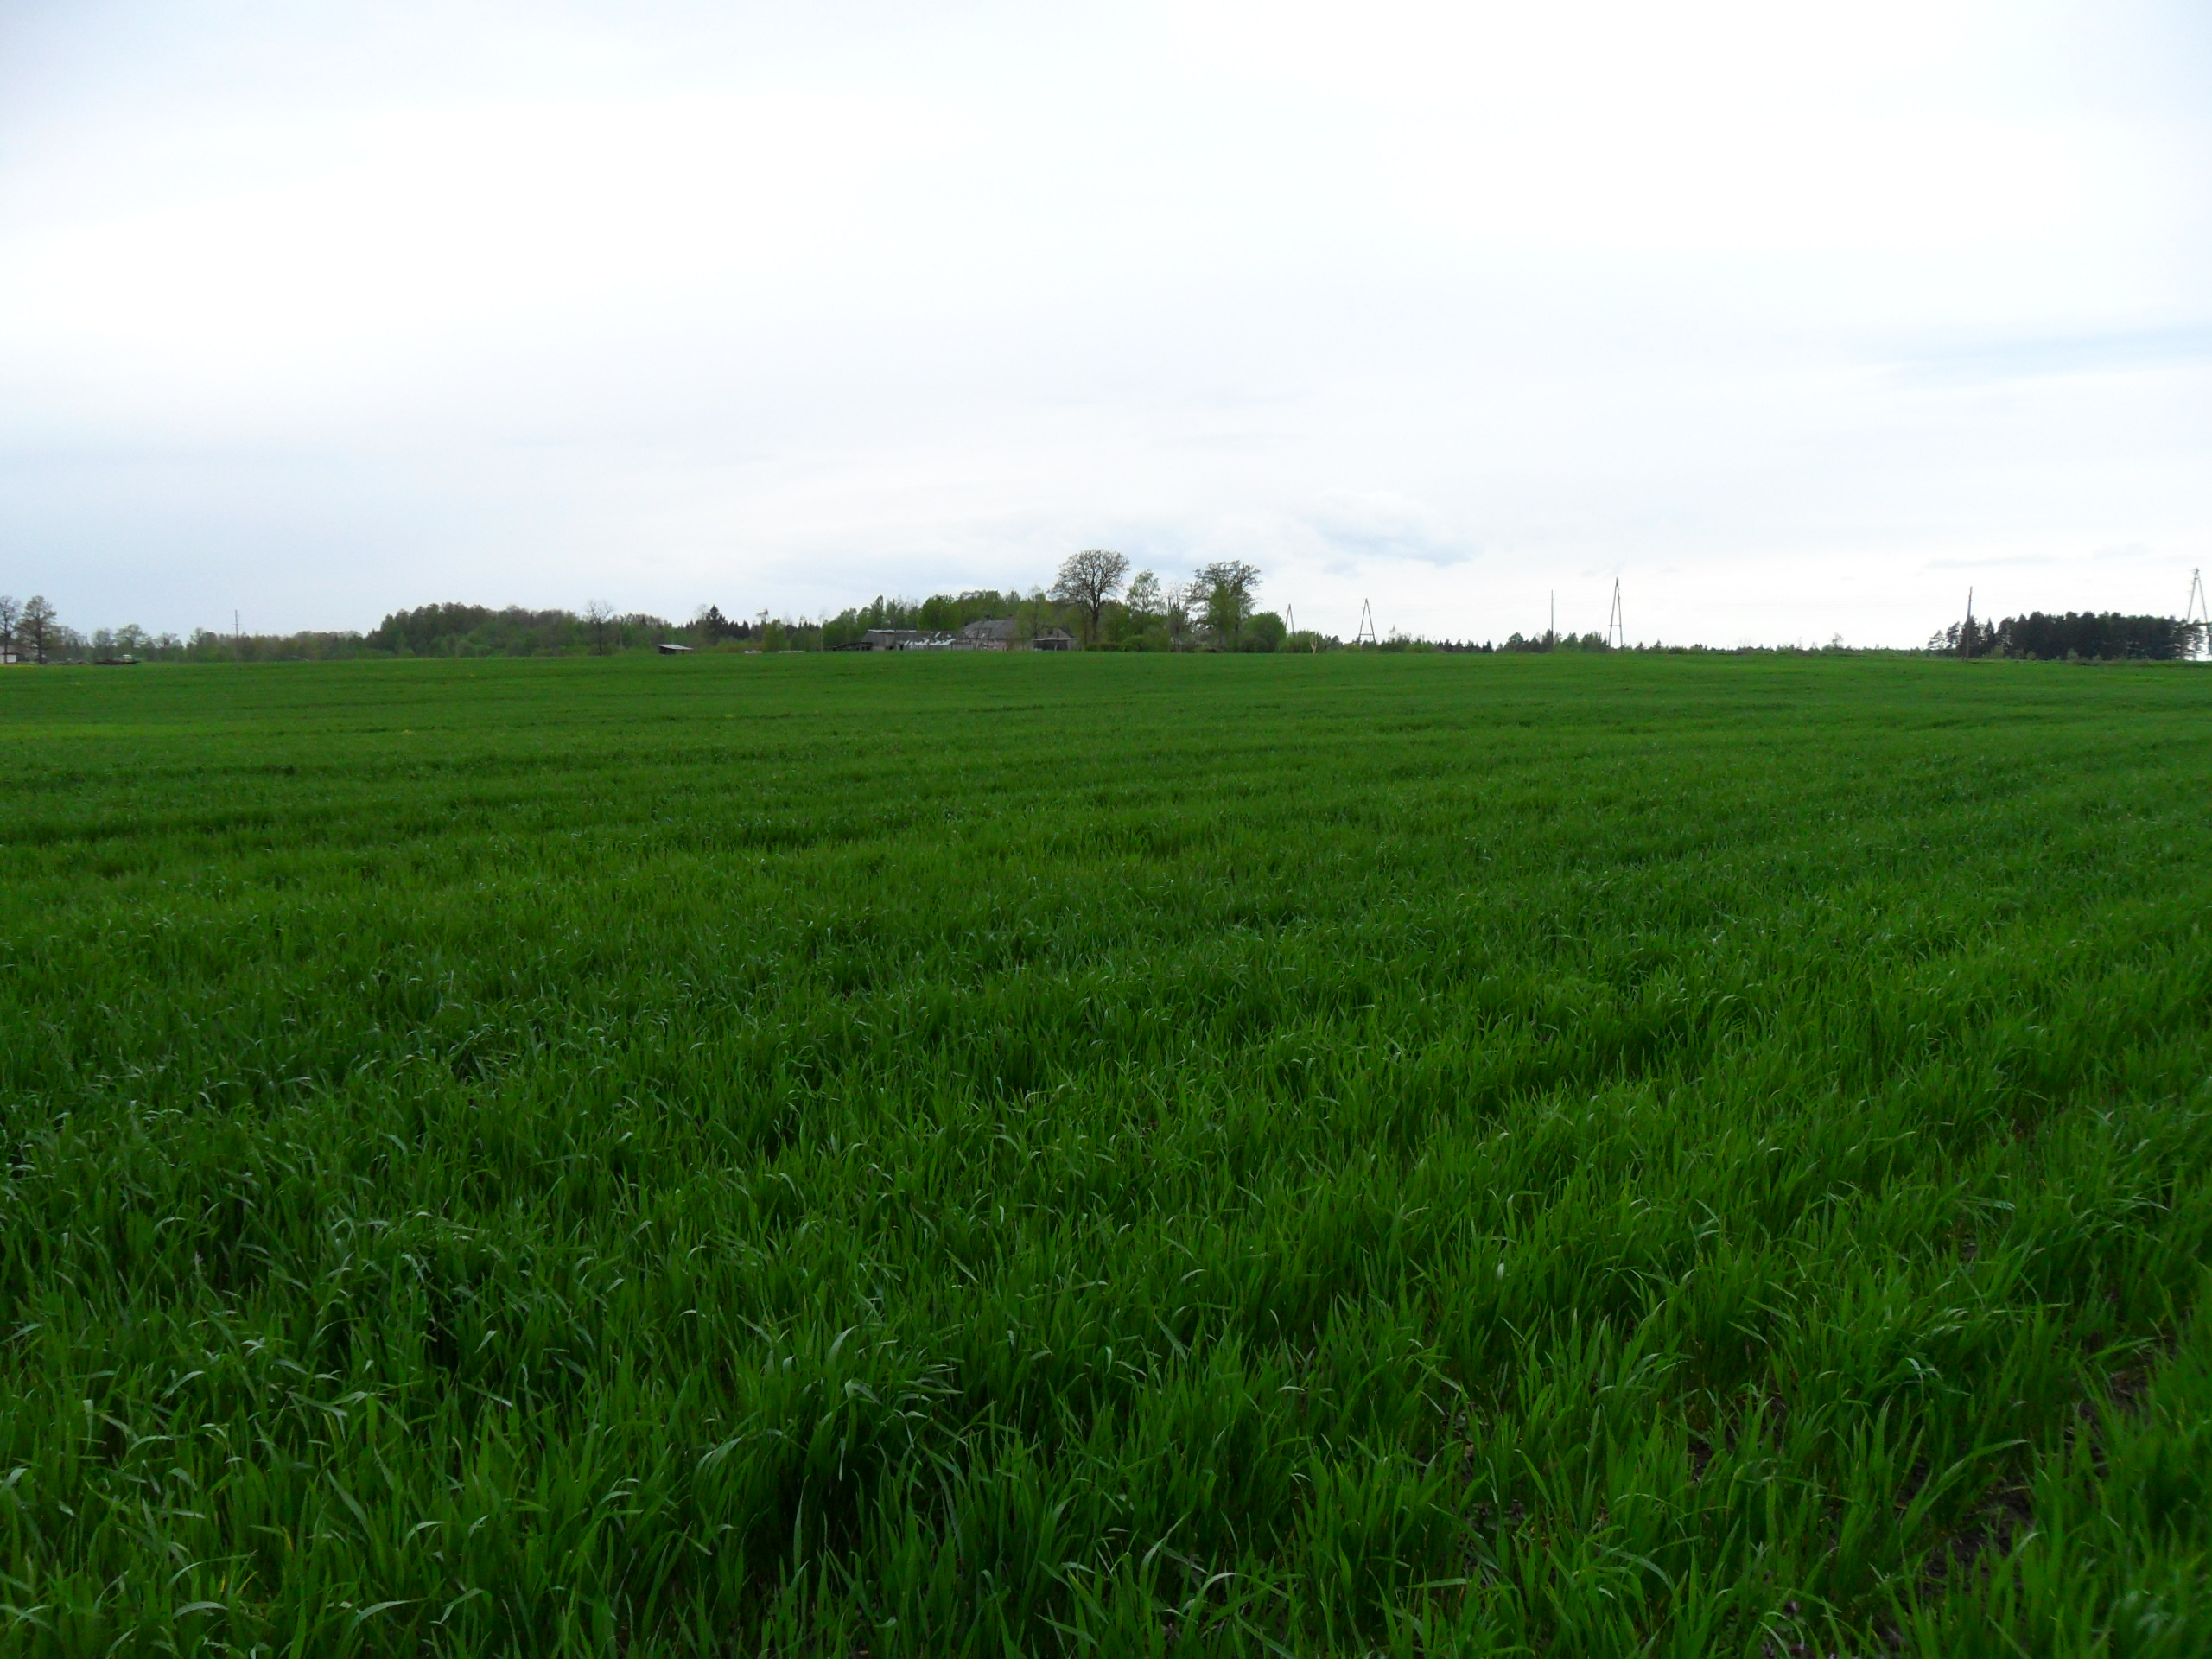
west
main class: Cropland
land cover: Common wheat
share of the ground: > 75 %
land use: Agriculture (excluding fallow land and kitchen gardens)
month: May
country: LV
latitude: 57.2999
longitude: 22.5517
